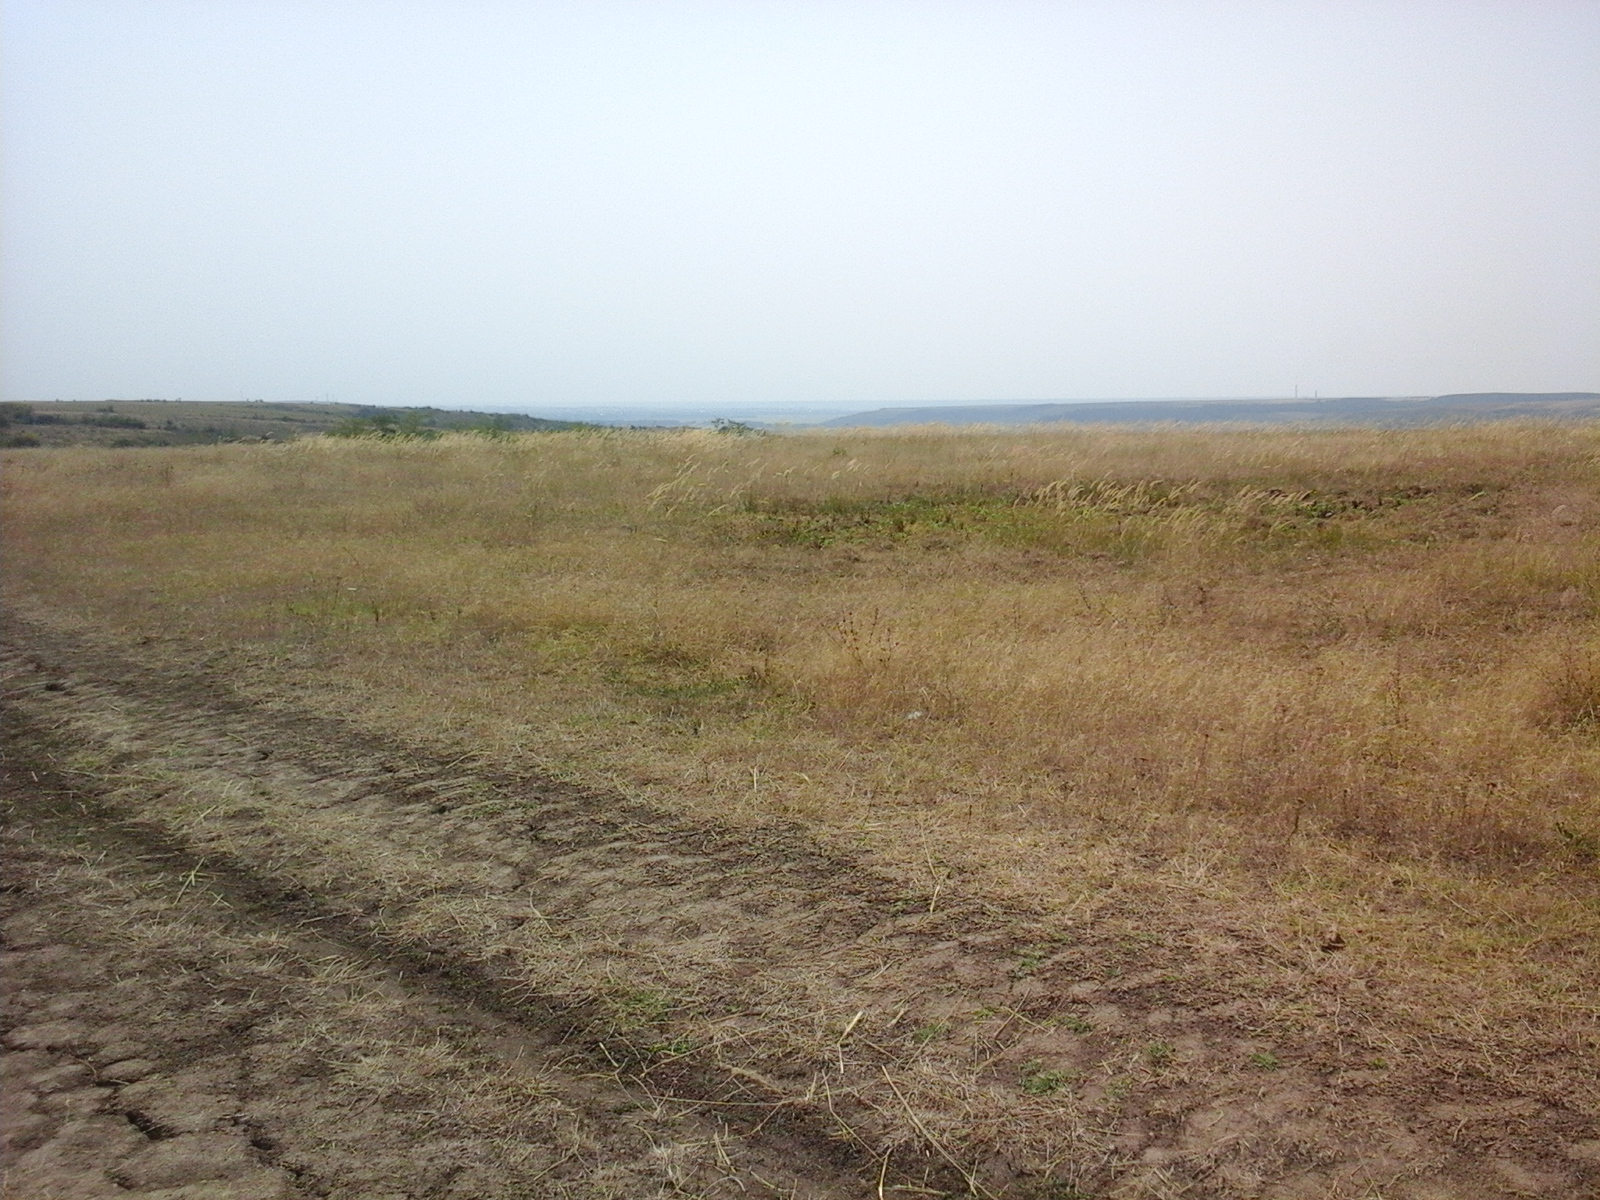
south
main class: Cropland
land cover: Sunflower
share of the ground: > 75 %
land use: Agriculture (excluding fallow land and kitchen gardens)
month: August
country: RO
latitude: 44.4866
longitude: 23.7762
